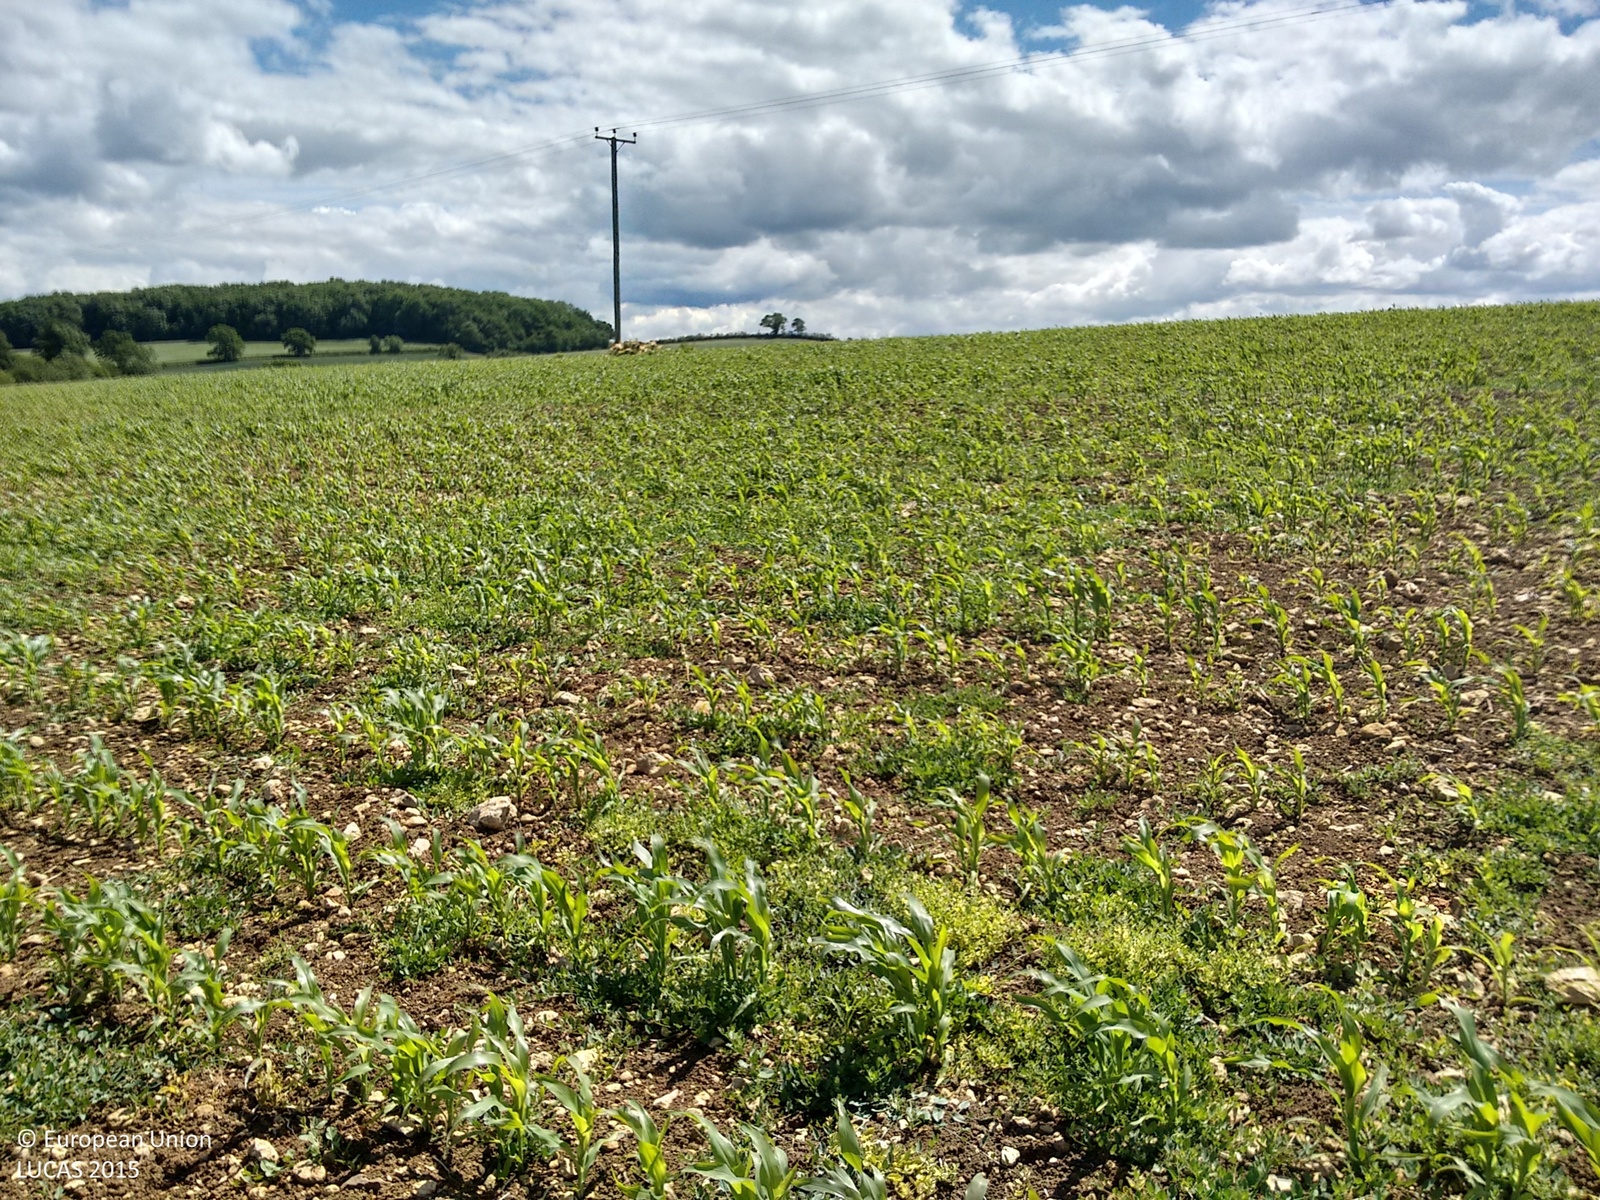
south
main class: Cropland
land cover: Maize
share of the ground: 10 - 25 %
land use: Agriculture (excluding fallow land and kitchen gardens)
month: June
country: GB
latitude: 51.2717
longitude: -2.3771
